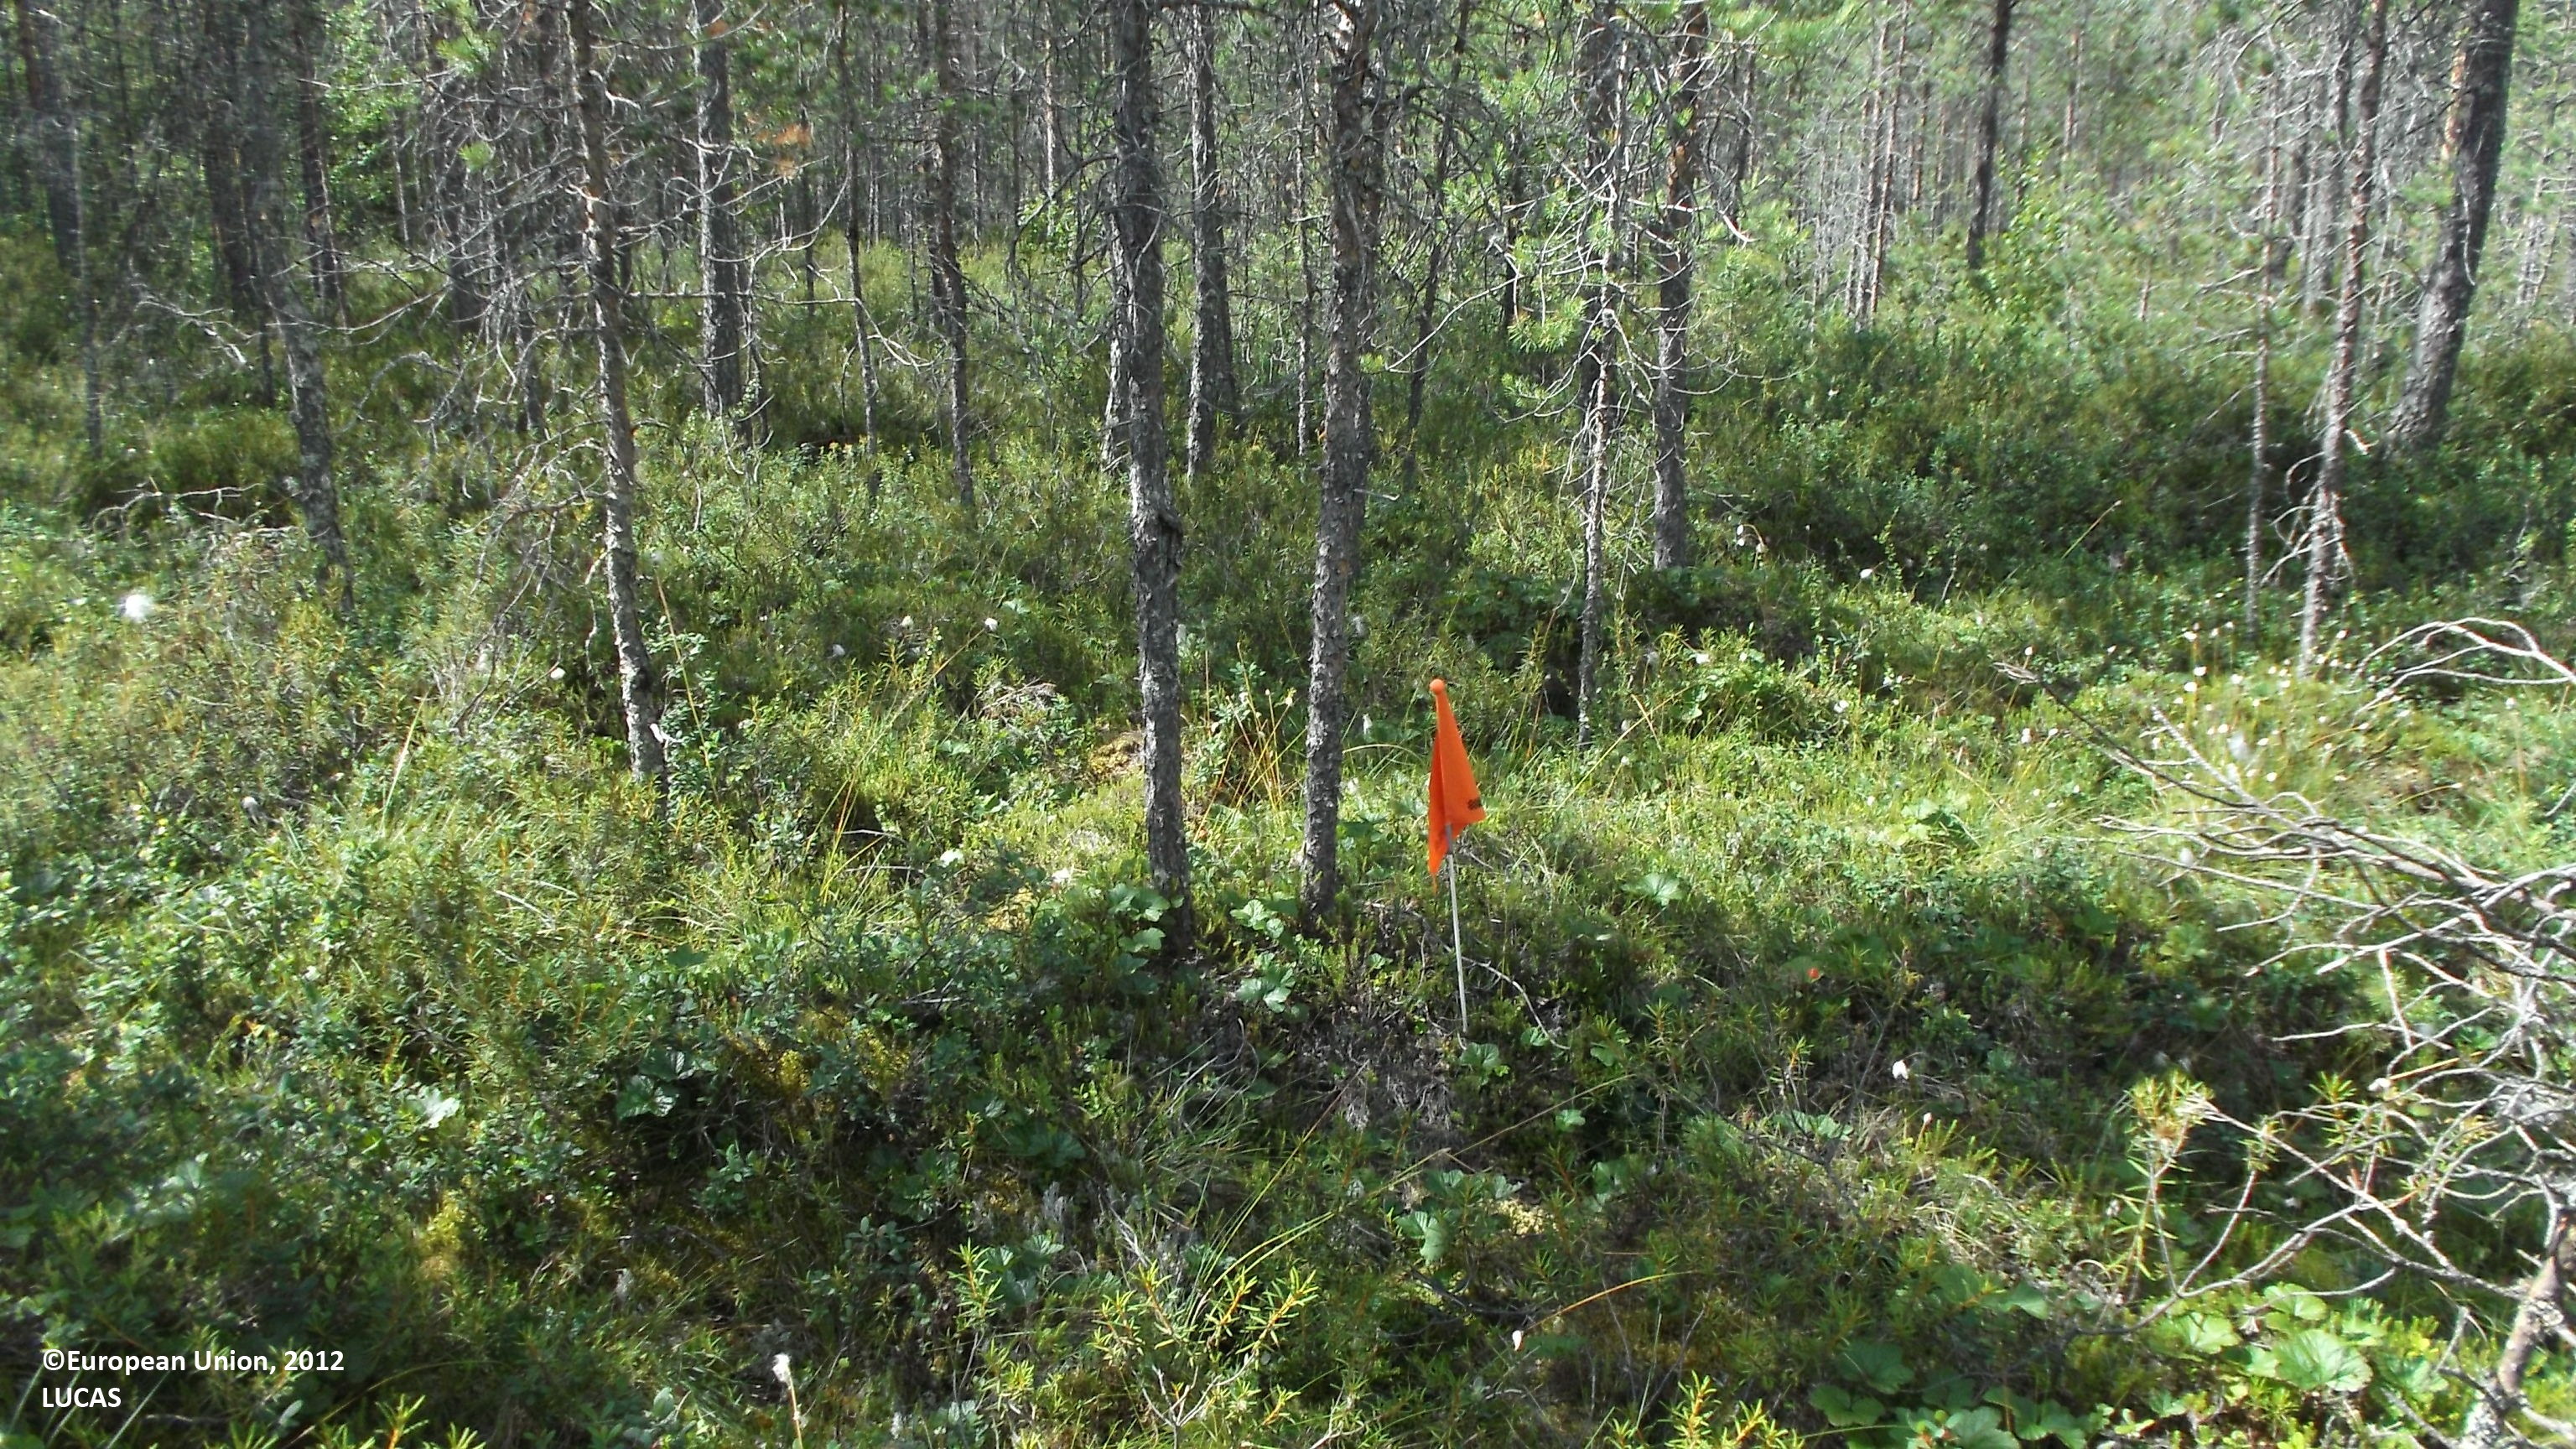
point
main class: Woodland
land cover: Pine dominated coniferous woodland
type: mire and swamp forests
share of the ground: 50 - 75 %
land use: Forestry
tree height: < 5 m
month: July
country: FI
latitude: 63.2730
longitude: 23.8415
